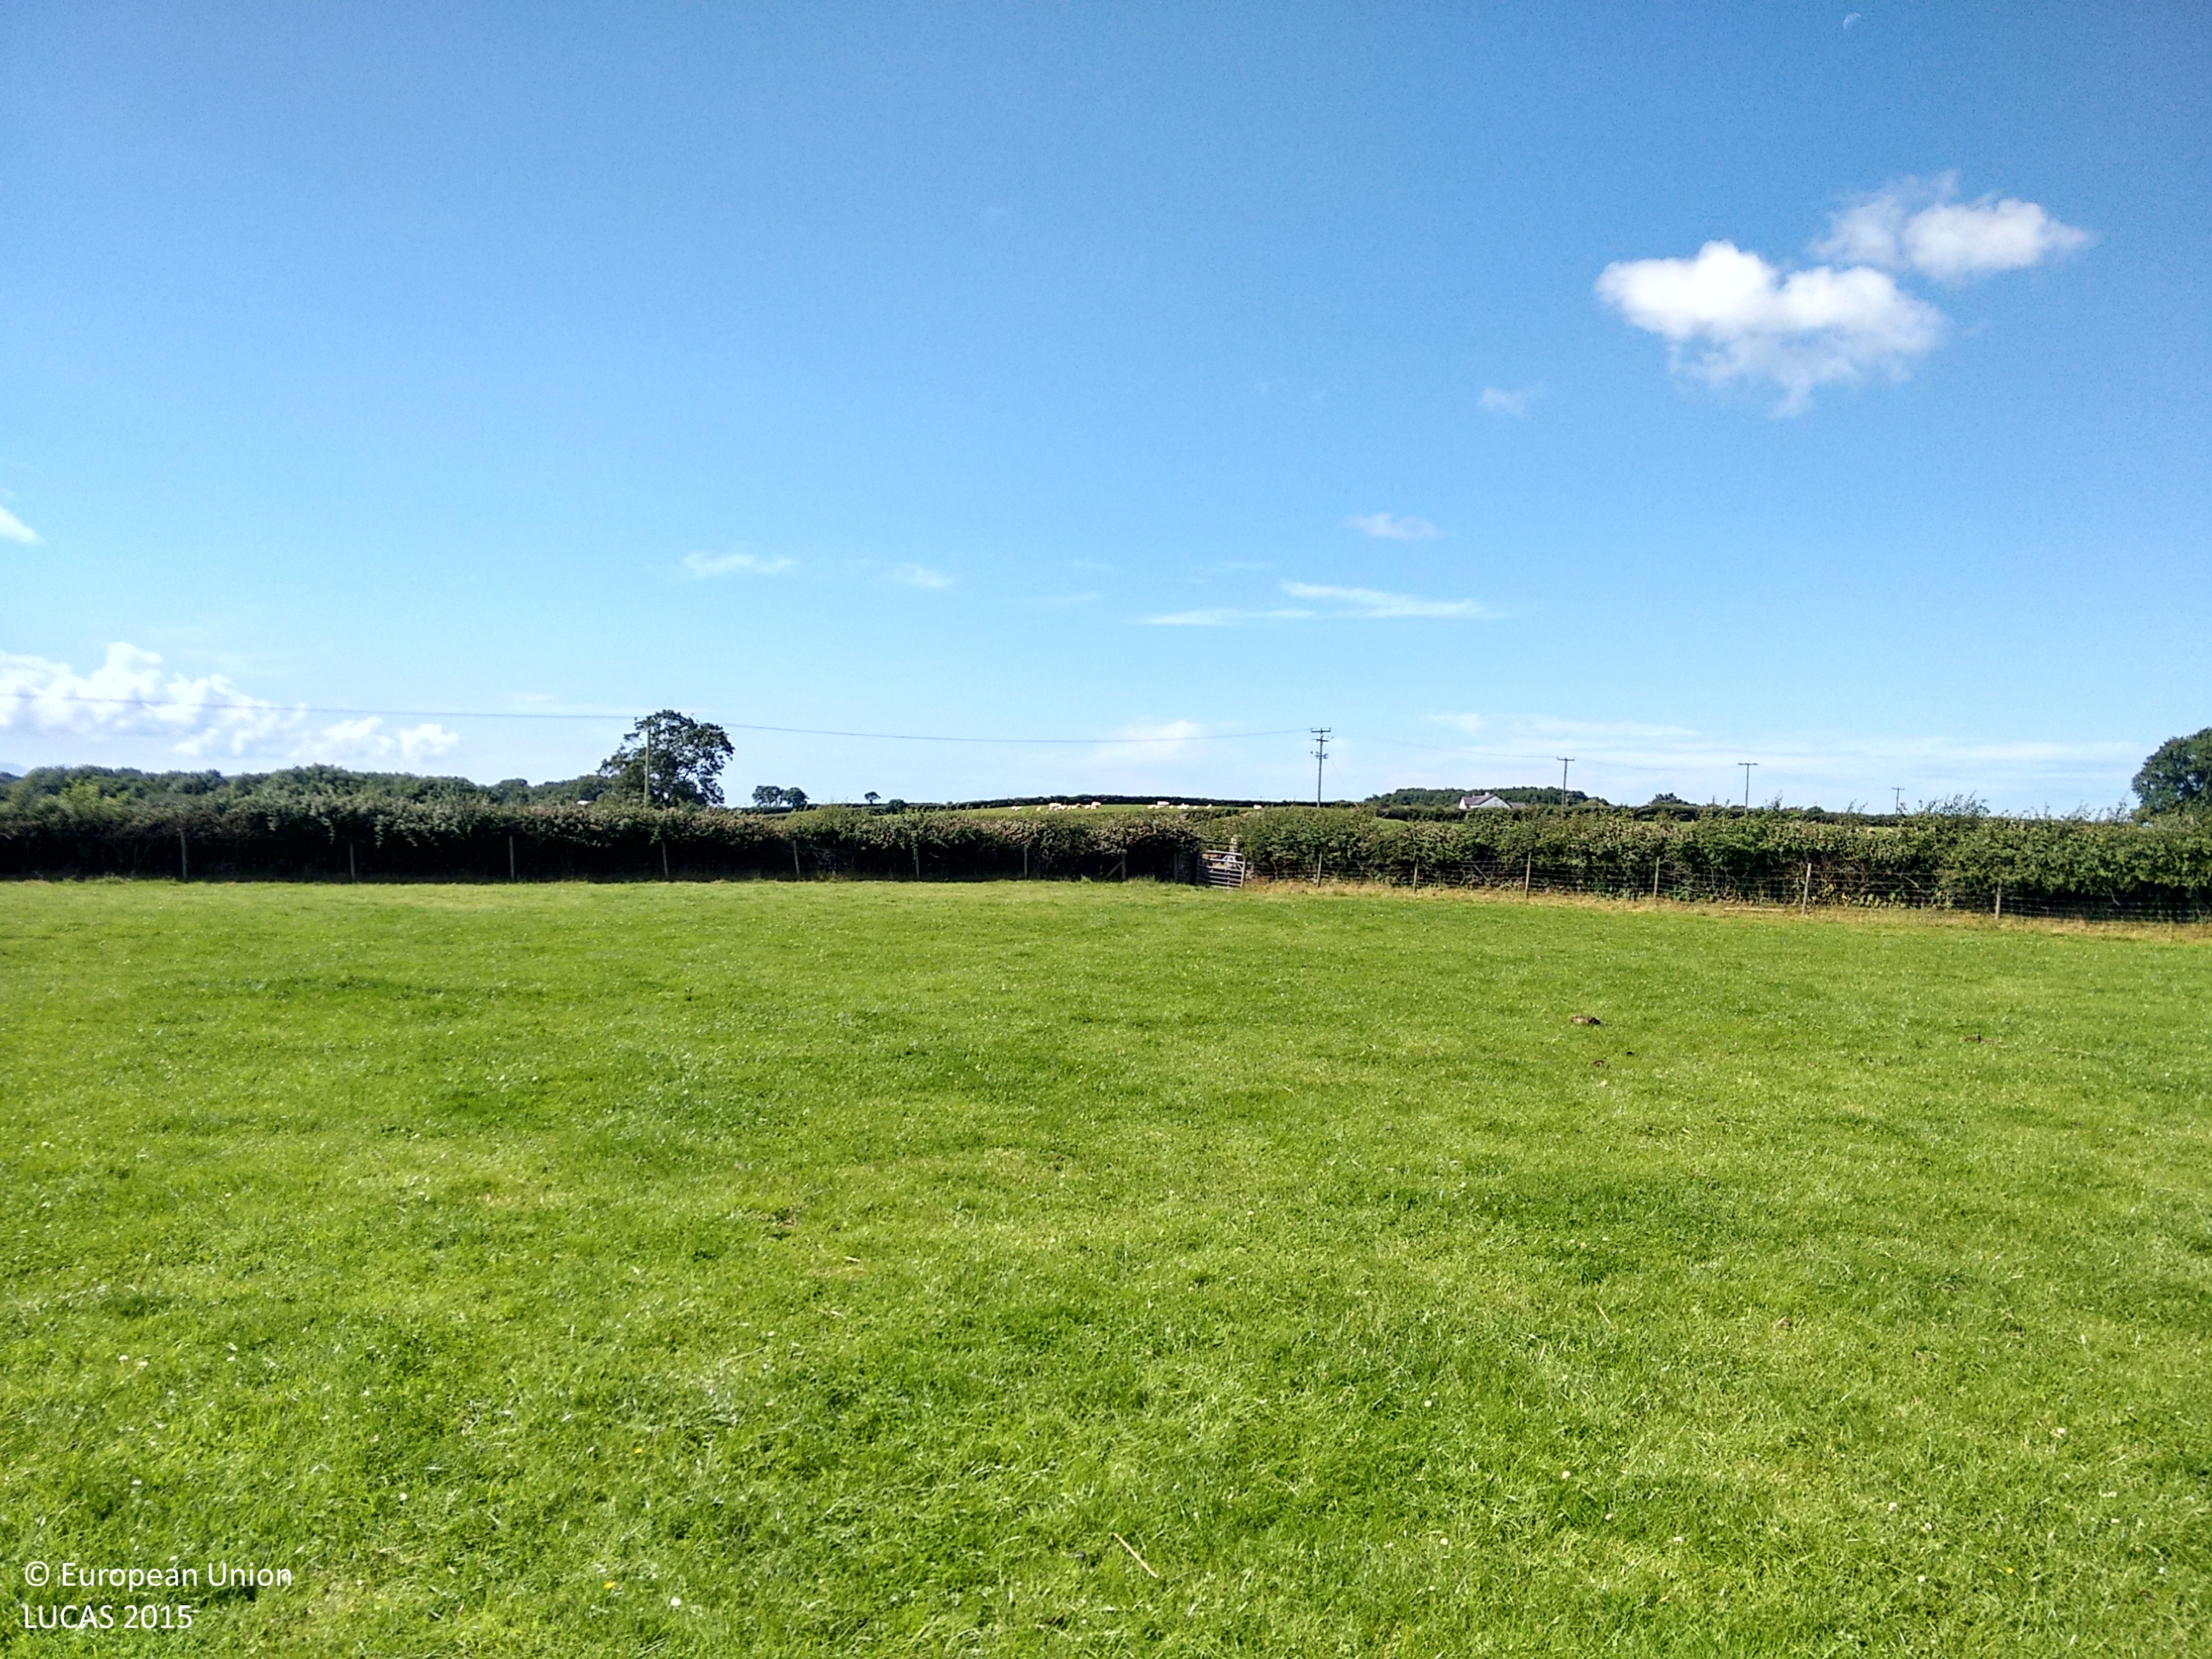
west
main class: Grassland
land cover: Grassland without tree/shrub cover
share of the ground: > 75 %
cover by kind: herbaceous plants 100 %
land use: Agriculture (excluding fallow land and kitchen gardens)
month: August
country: GB
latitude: 53.1865
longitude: -4.3026
